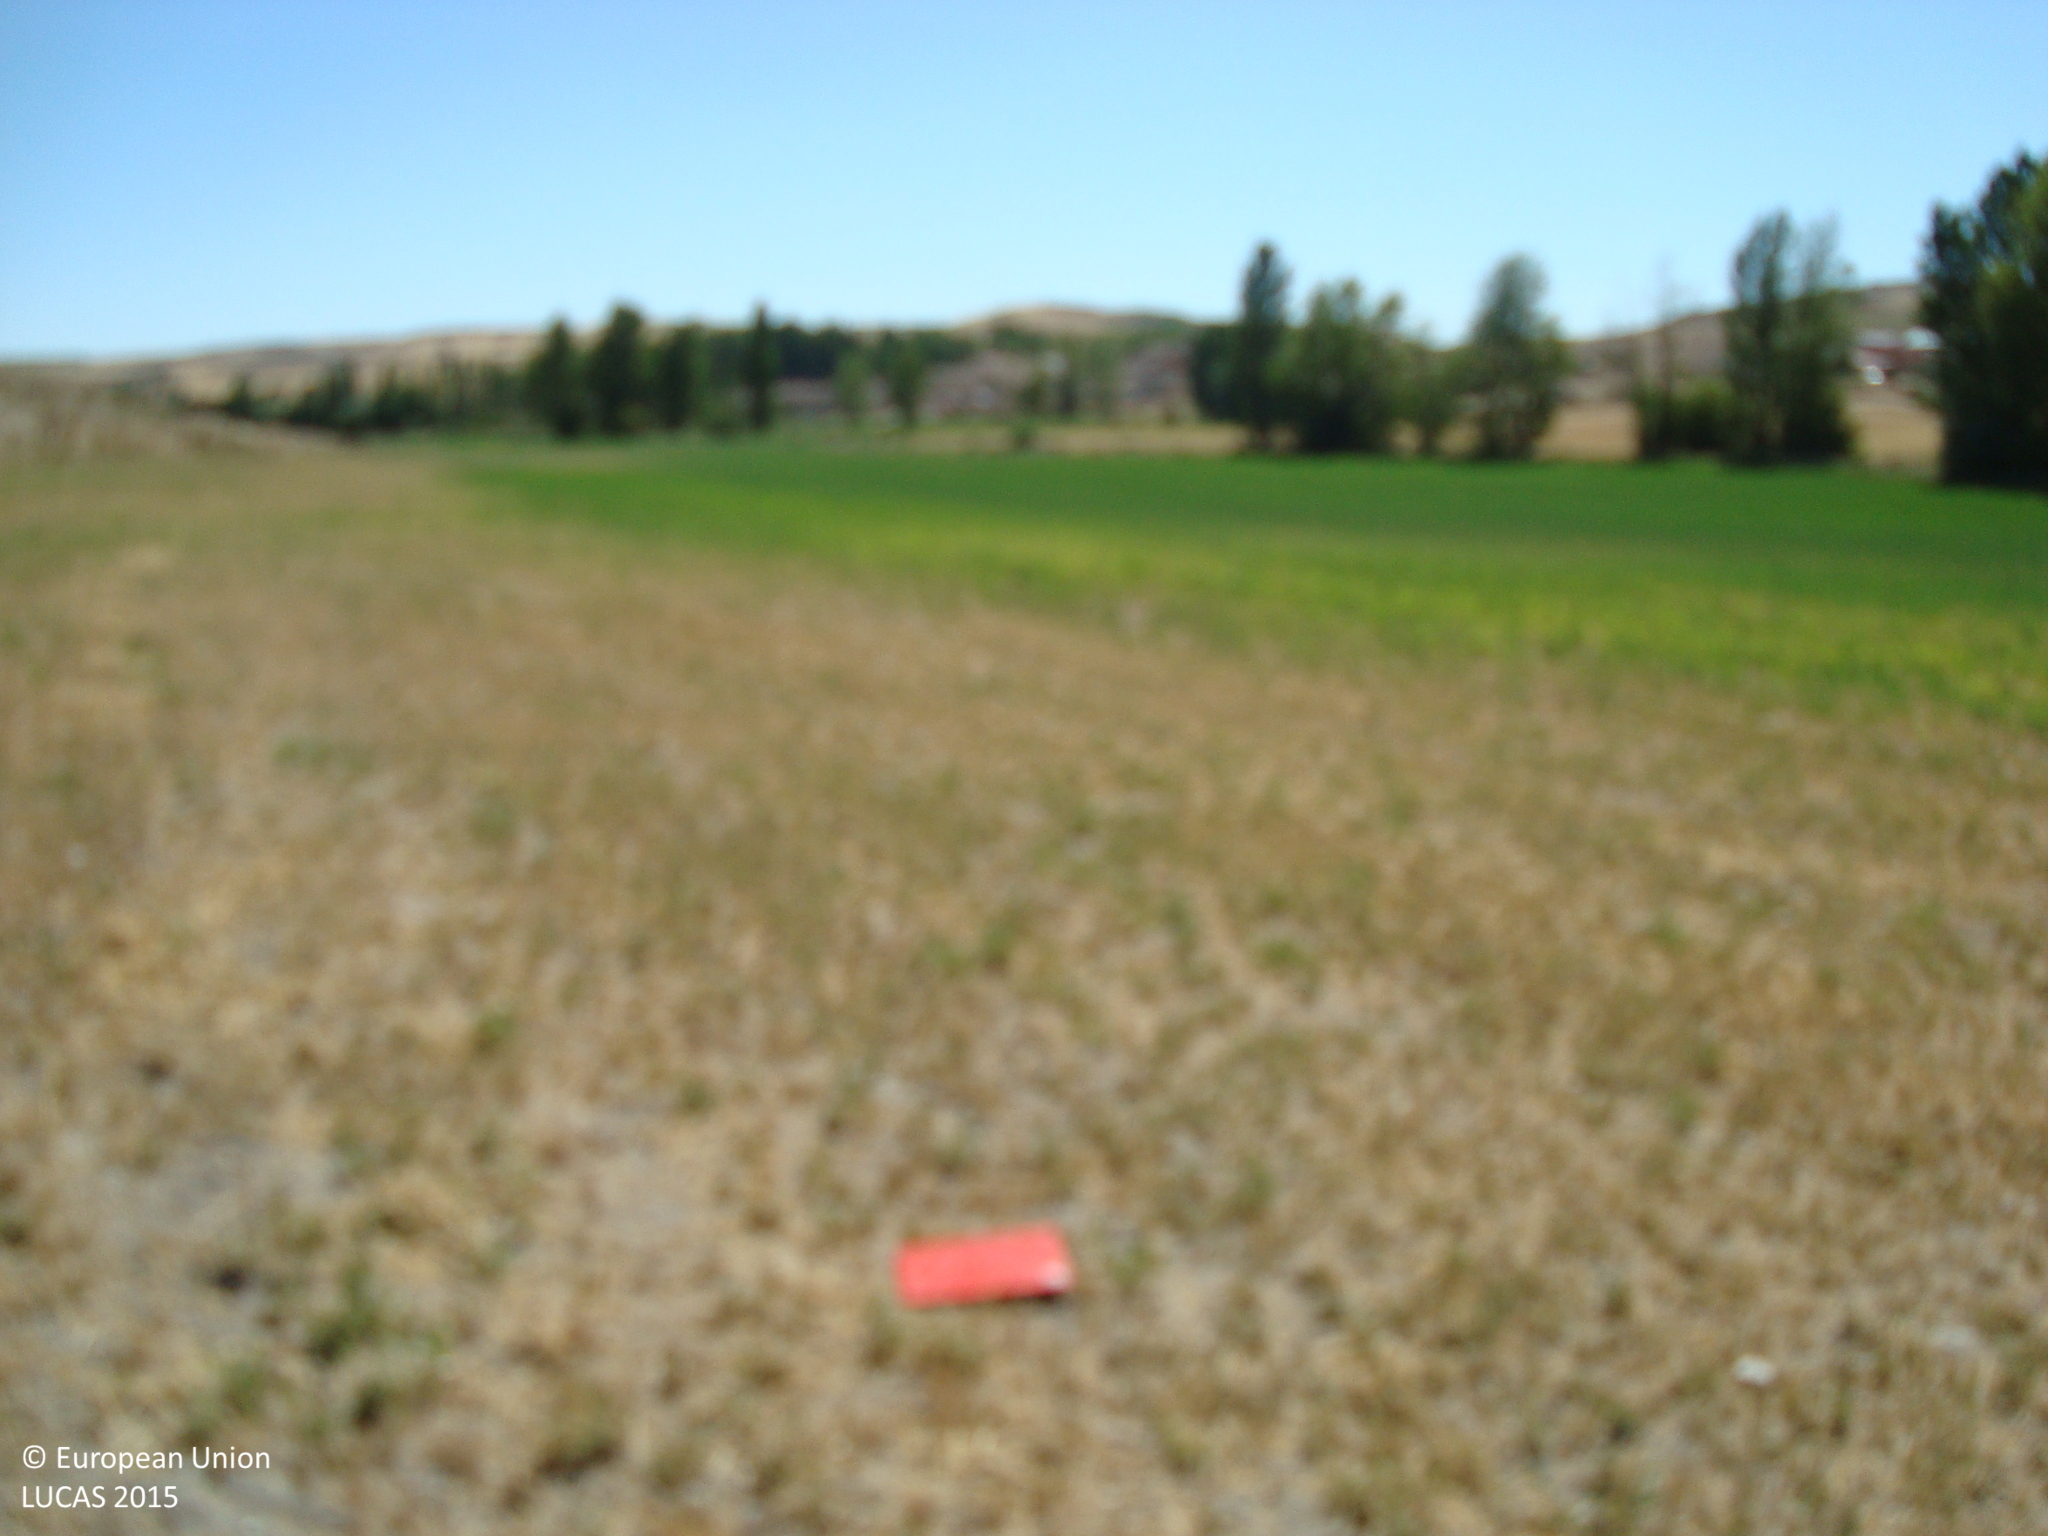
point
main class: Cropland
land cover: Lucerne
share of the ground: > 75 %
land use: Agriculture (excluding fallow land and kitchen gardens)
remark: Harvested field
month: August
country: ES
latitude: 42.1862
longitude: -4.1476
